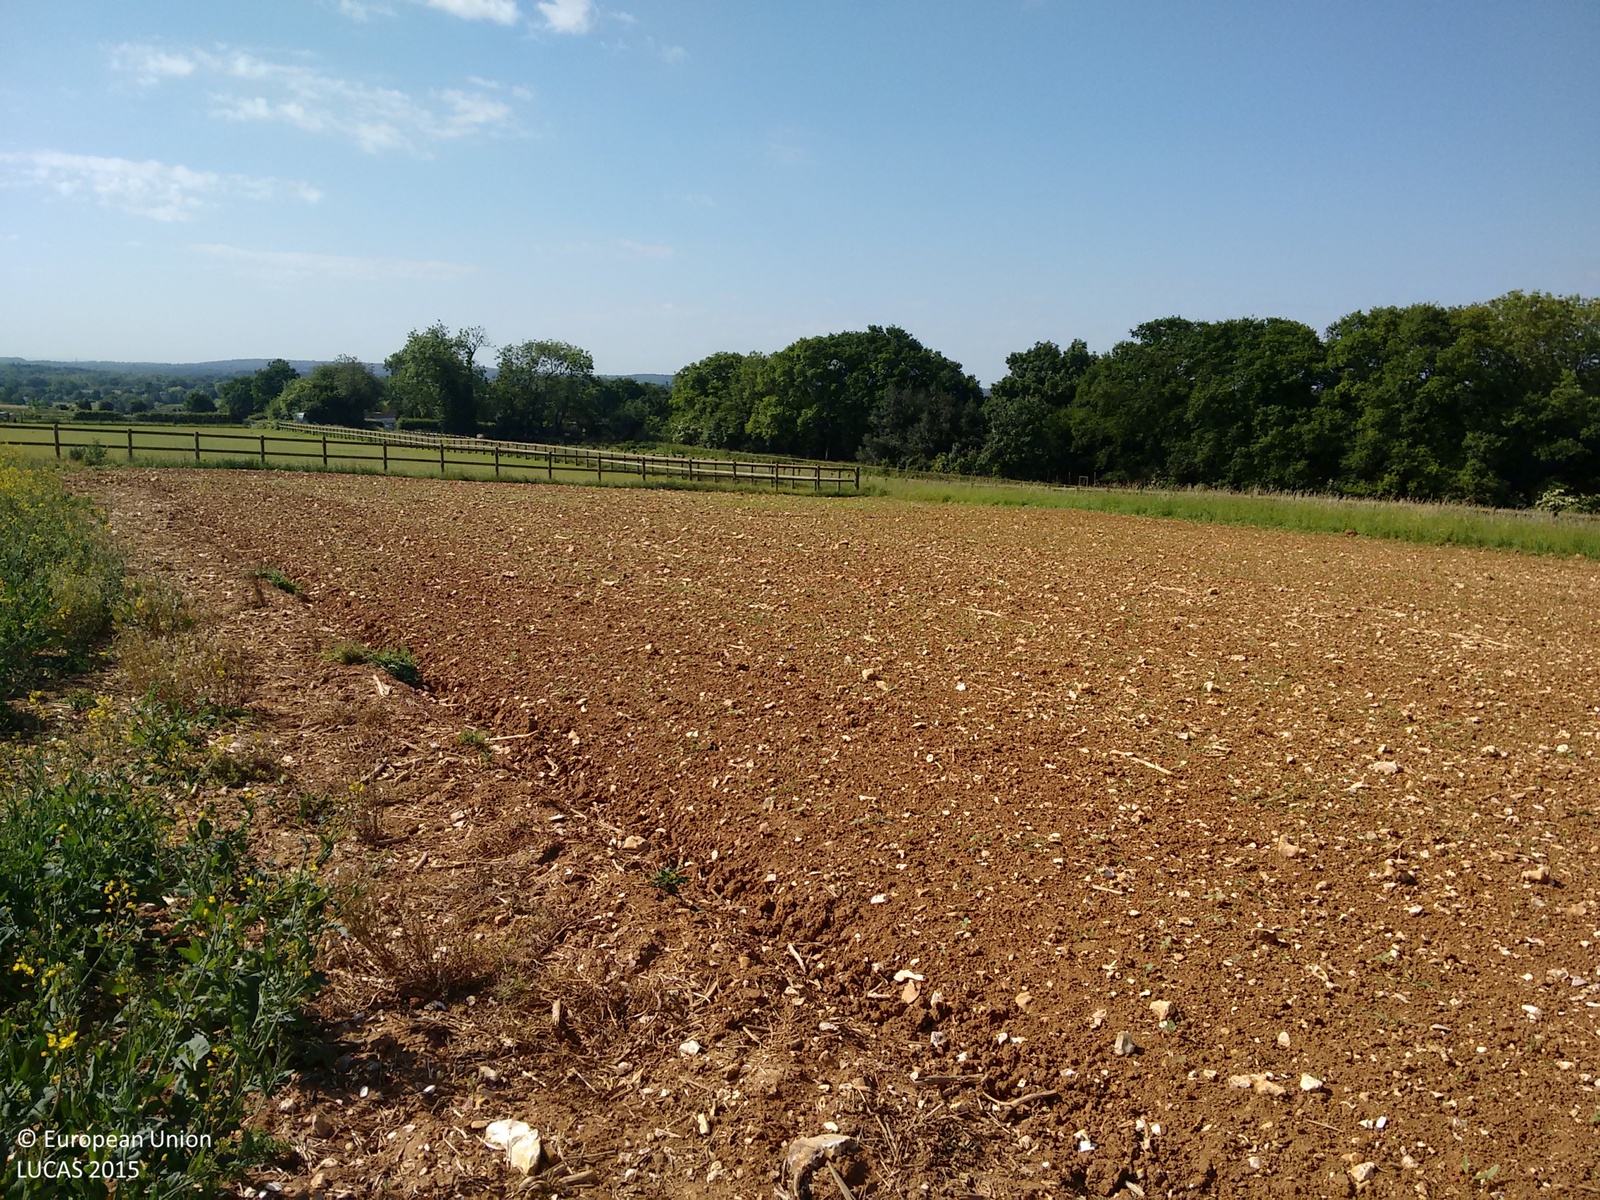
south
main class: Cropland
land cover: Rape and turnip rape
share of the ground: > 75 %
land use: Agriculture (excluding fallow land and kitchen gardens)
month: June
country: GB
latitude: 51.0180
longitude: -1.6715
